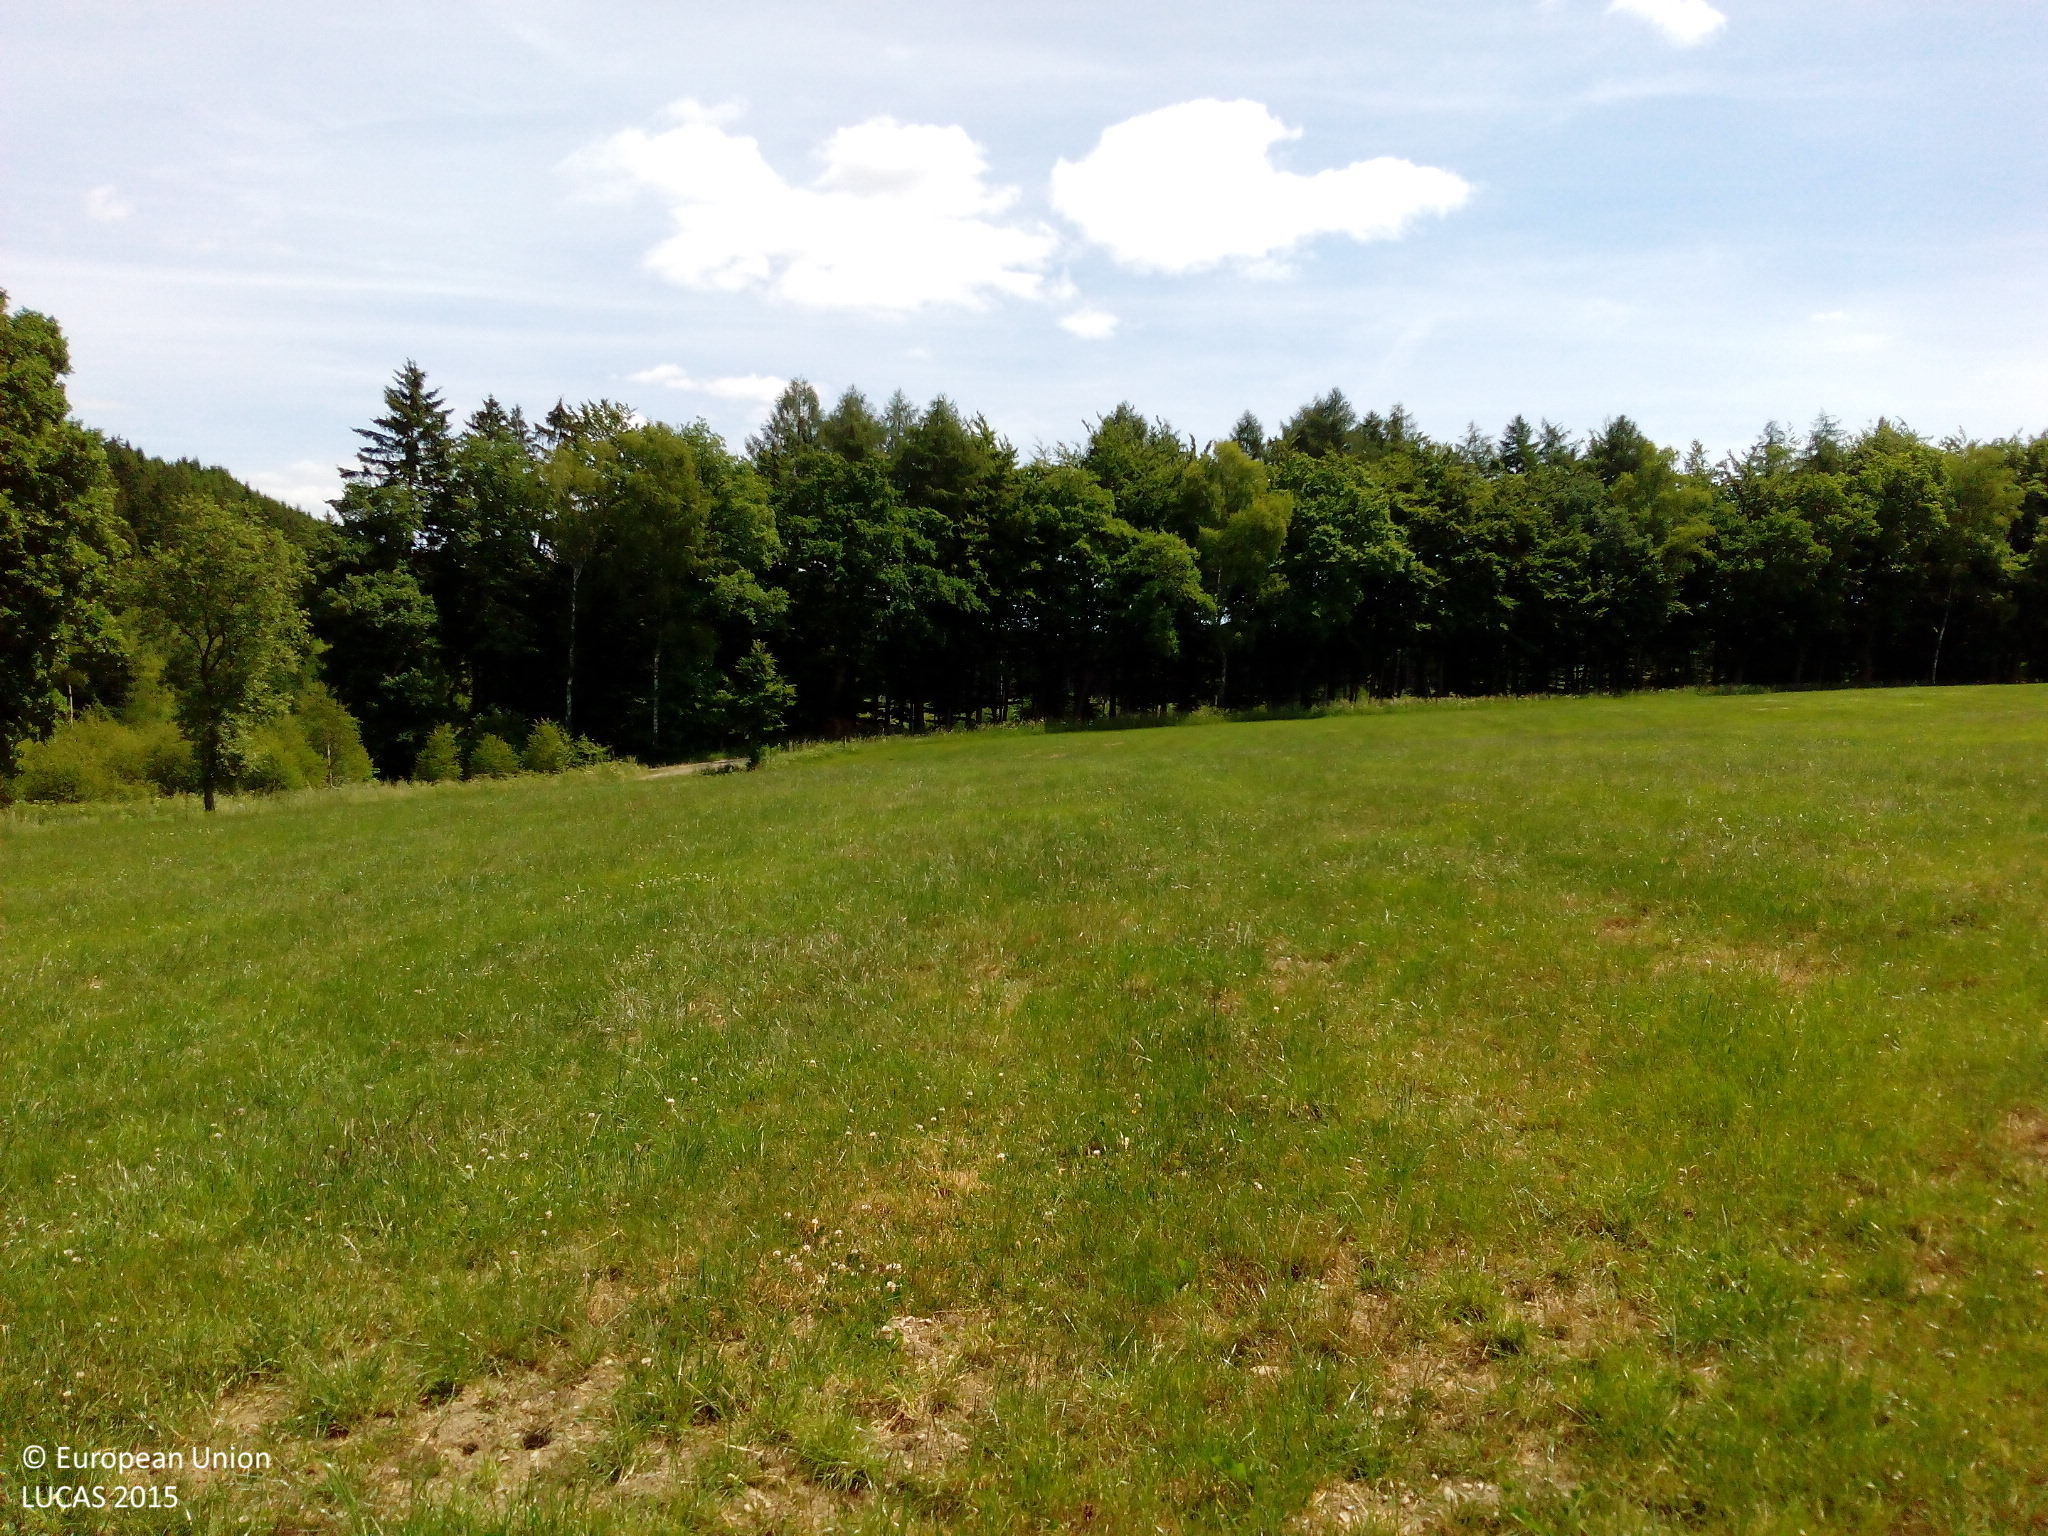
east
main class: Grassland
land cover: Grassland without tree/shrub cover
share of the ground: > 75 %
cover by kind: herbaceous plants 100 %
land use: Agriculture (excluding fallow land and kitchen gardens)
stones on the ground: < 10 %
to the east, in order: Grassland without tree/shrub cover; Shruby margins; Single bushes/trees; Ditches and canals; Shruby margins; Tracks; Broadleaved woodland
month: June
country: DE
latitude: 51.4506
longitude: 8.4606
